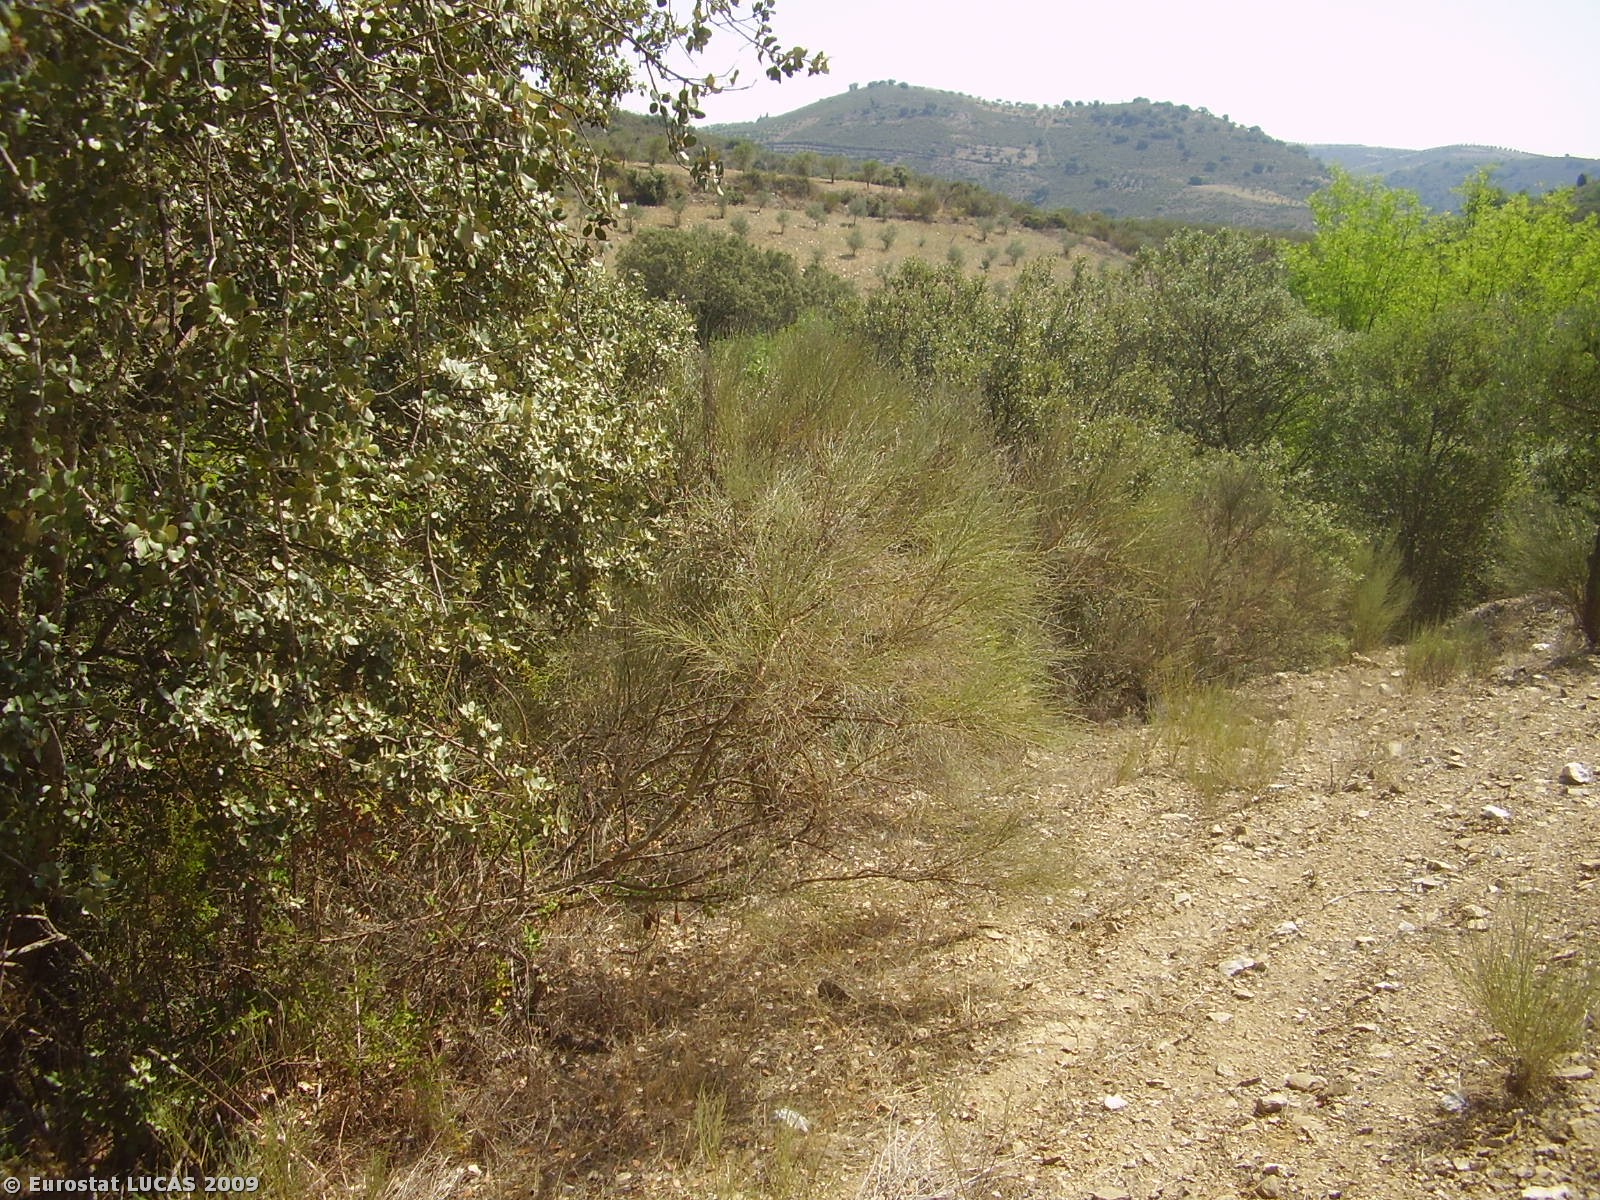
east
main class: Cropland
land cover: Olive groves
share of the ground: 10 - 25 %
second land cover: Spontaneously vegetated surfaces
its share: < 10 %
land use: Agriculture (excluding fallow land and kitchen gardens)
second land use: Fallow land
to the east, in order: Olive groves; Spontaneously vegetated surfaces; Olive groves; Broadleaved woodland; Tracks; Lines of trees; Rivers and streams; Lines of trees; Spontaneously vegetated surfaces; Lines of trees; Olive groves; Tracks; Olive groves; Shrubland with sparse tree cover; Tracks; Shrubland with sparse tree cover
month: August
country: PT
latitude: 41.4366
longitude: -6.8285
